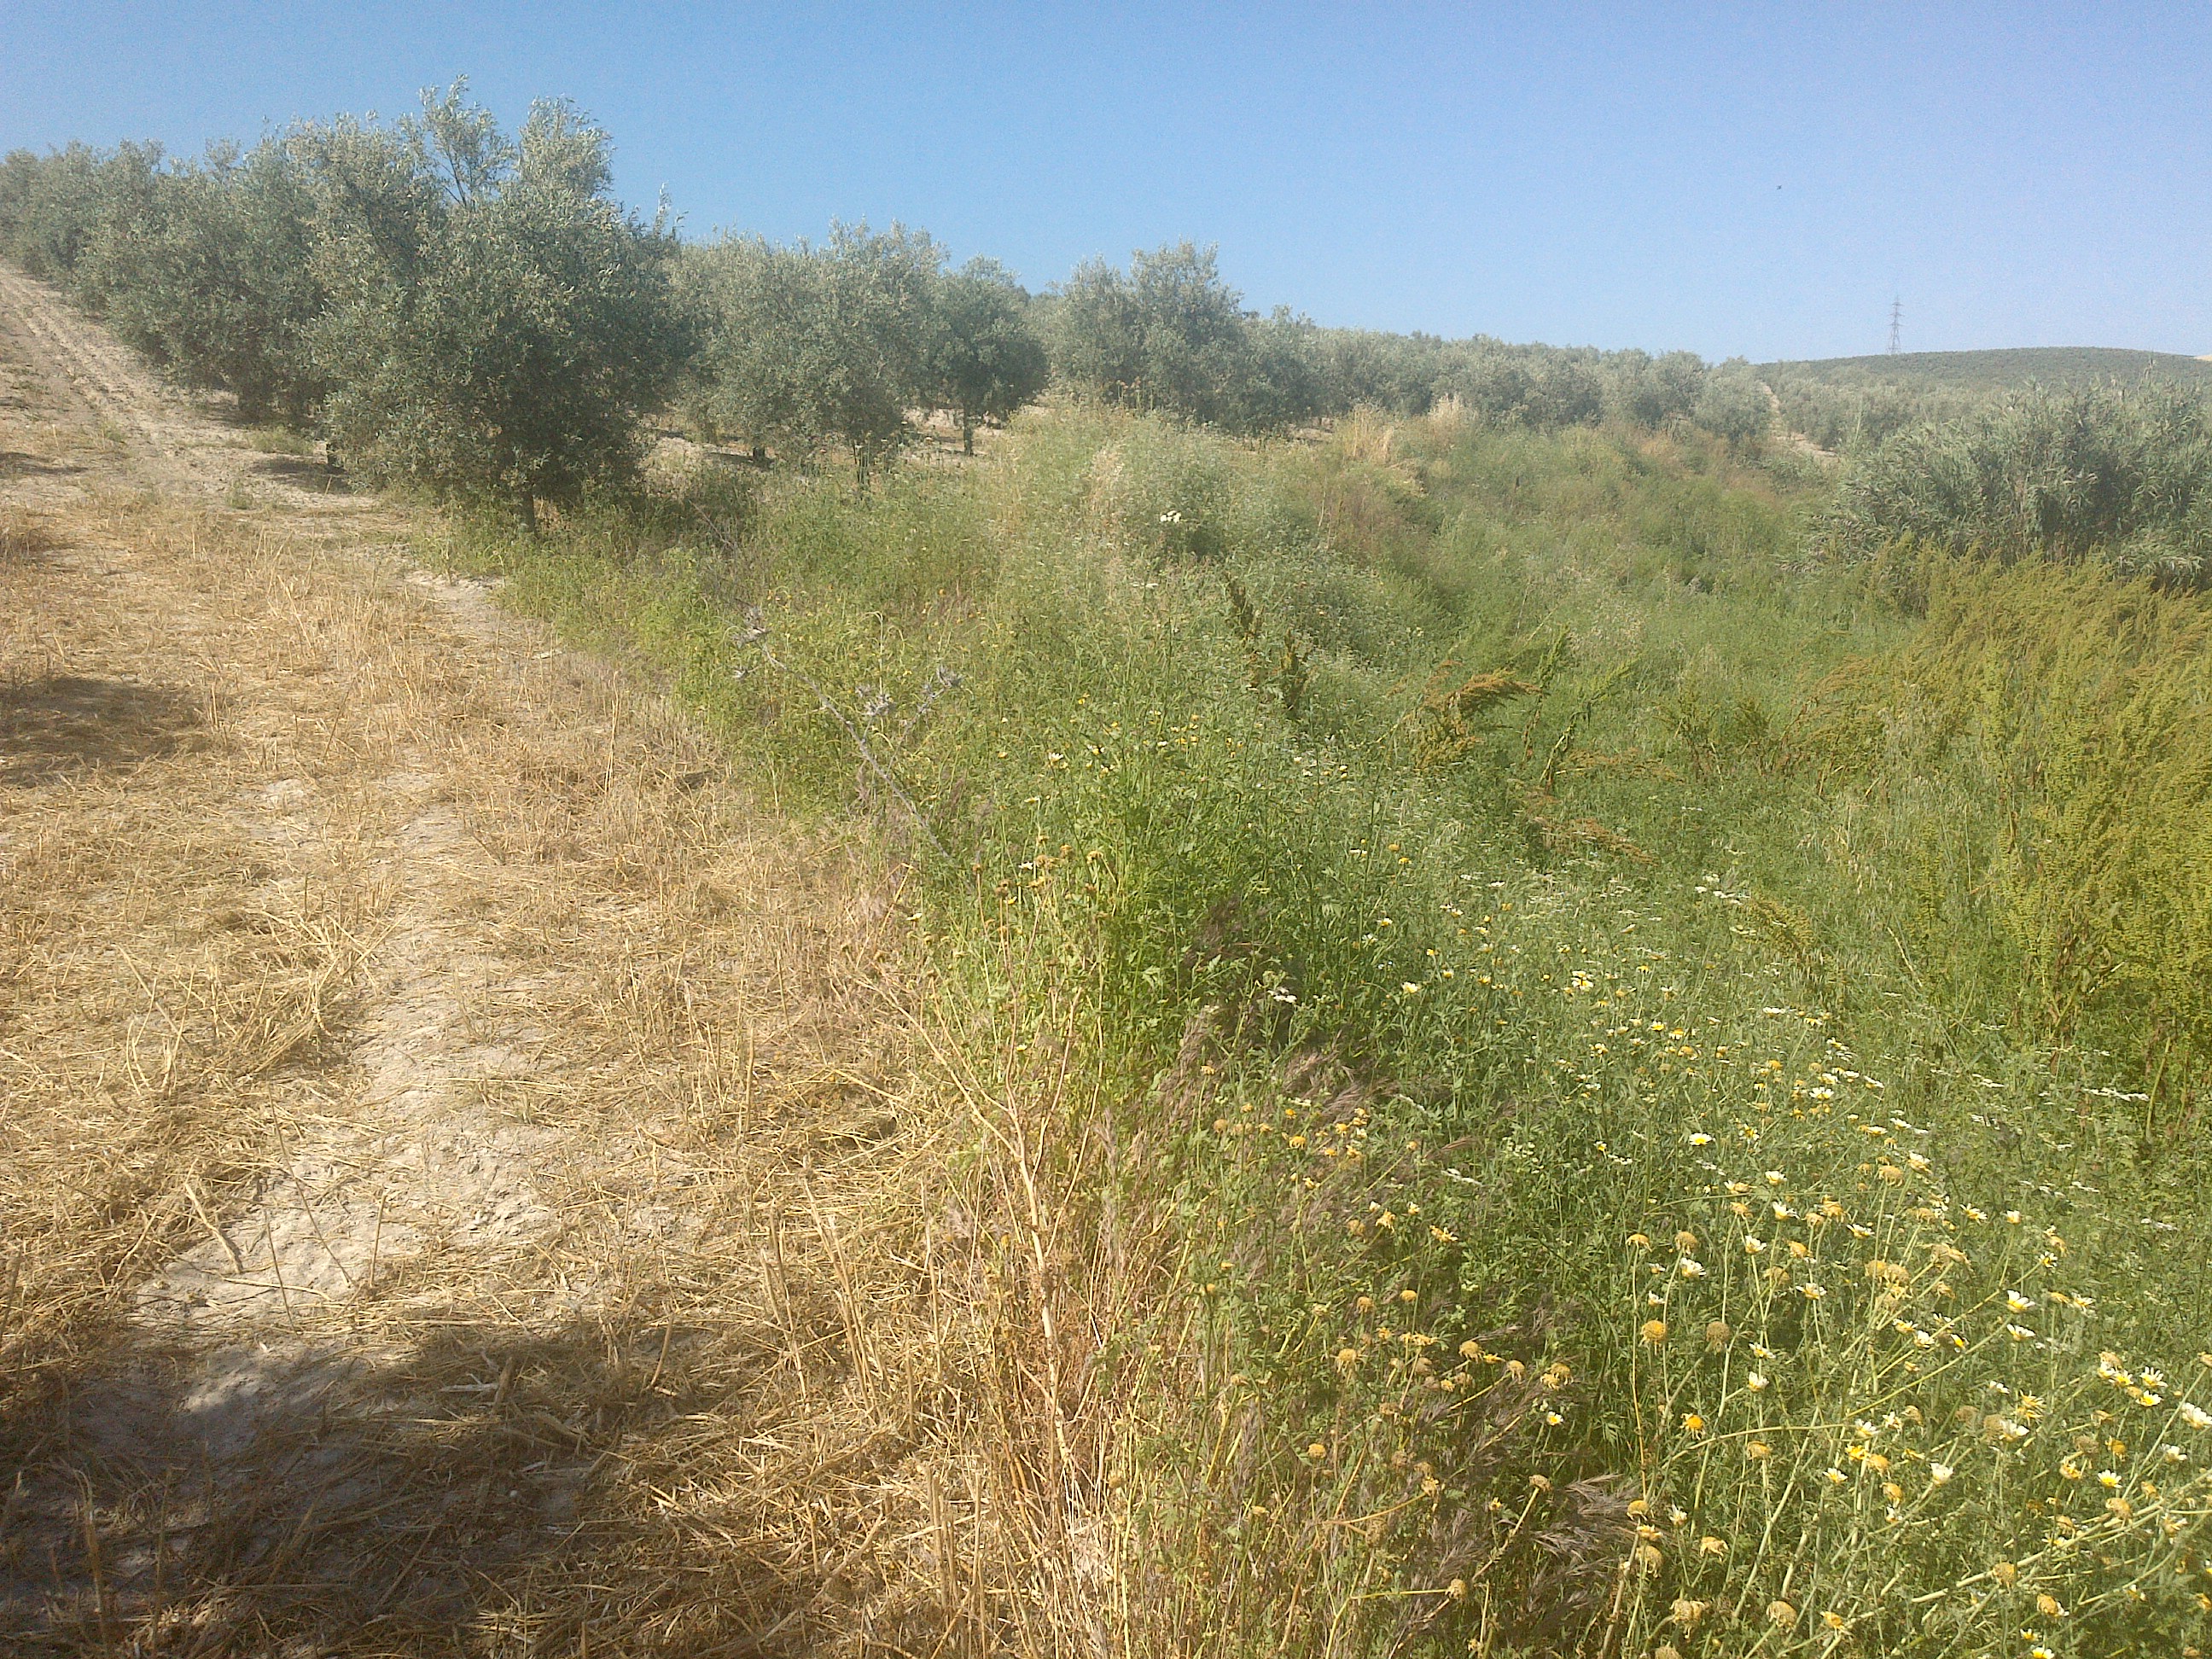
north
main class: Shrubland
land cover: Shrubland with sparse tree cover
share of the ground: 25 - 50 %
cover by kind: shrubs 65 %, herbaceous plants 30 %, broadleaved forest trees 5 %
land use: Semi-natural and natural areas not in use
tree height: < 5 m
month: May
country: ES
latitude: 37.7837
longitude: -4.6471
